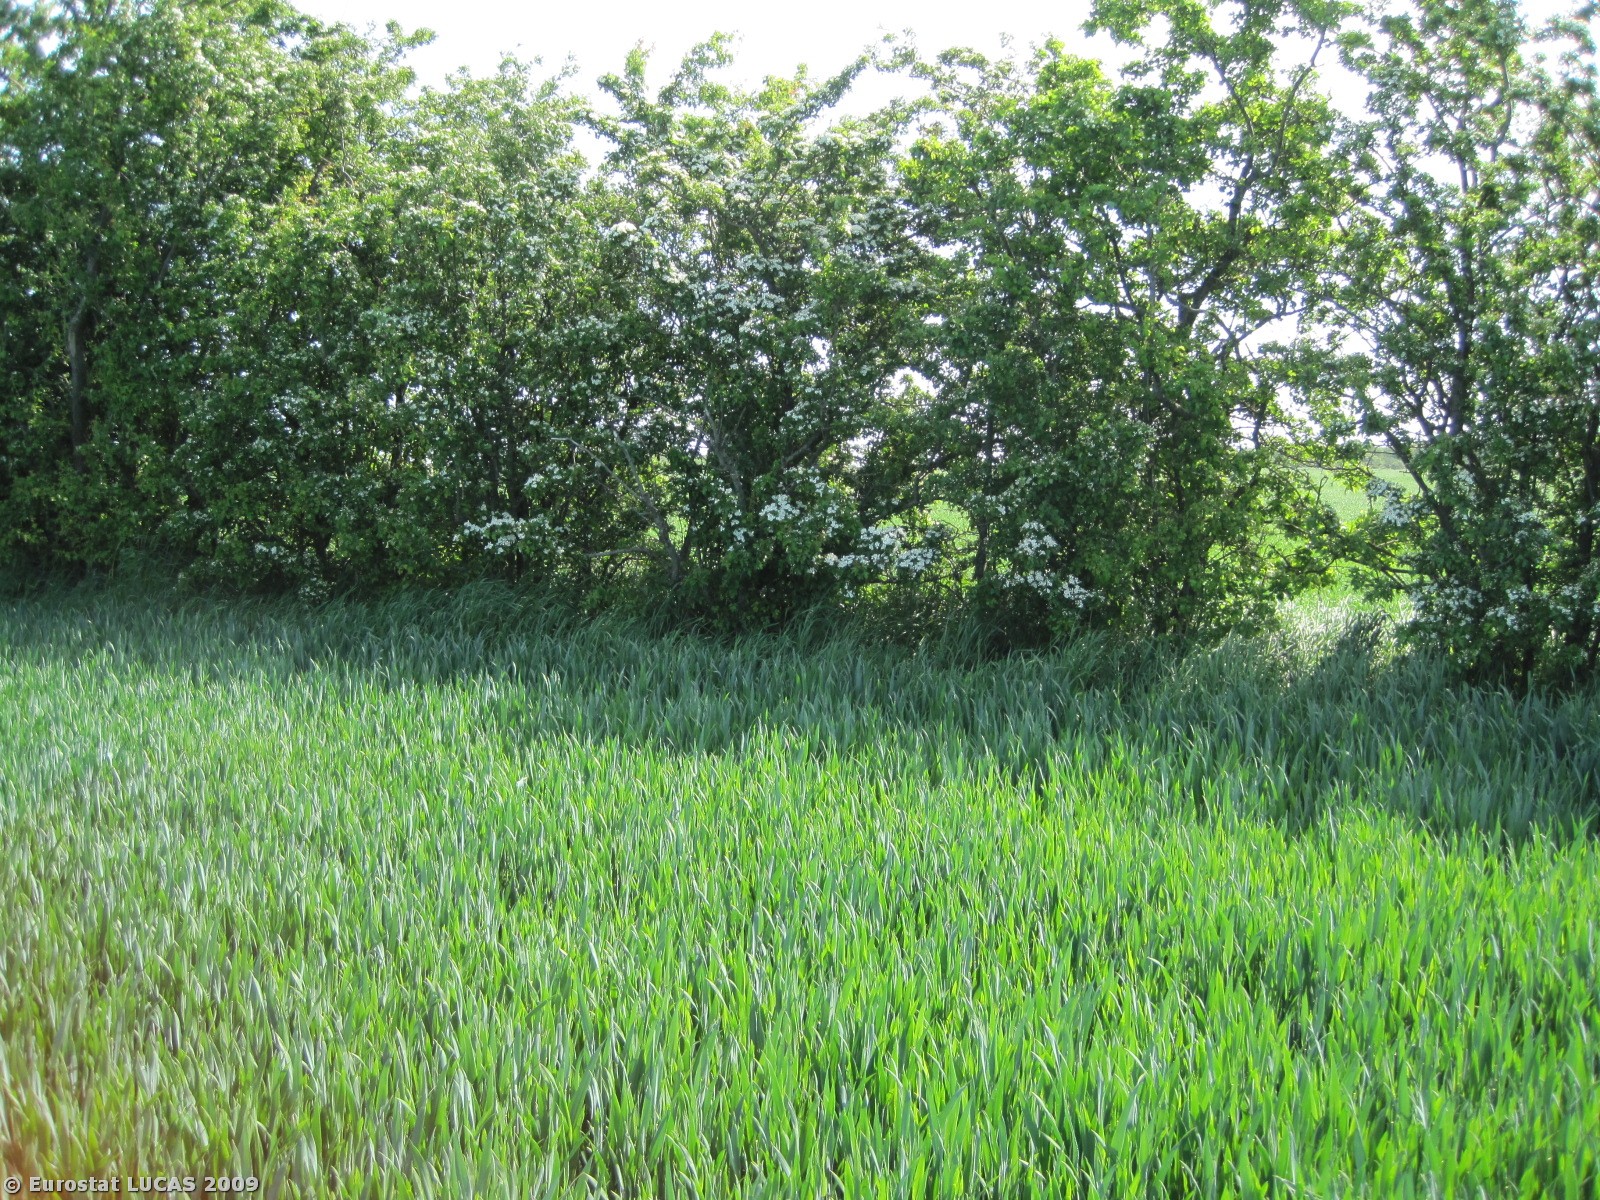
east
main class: Cropland
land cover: Common wheat
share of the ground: > 75 %
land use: Agriculture (excluding fallow land and kitchen gardens)
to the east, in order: Common wheat; Grass margins; Managed hedges; Grass margins; Barley; Grass margins; Barley
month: May
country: DK
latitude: 56.5112
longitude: 10.1785
